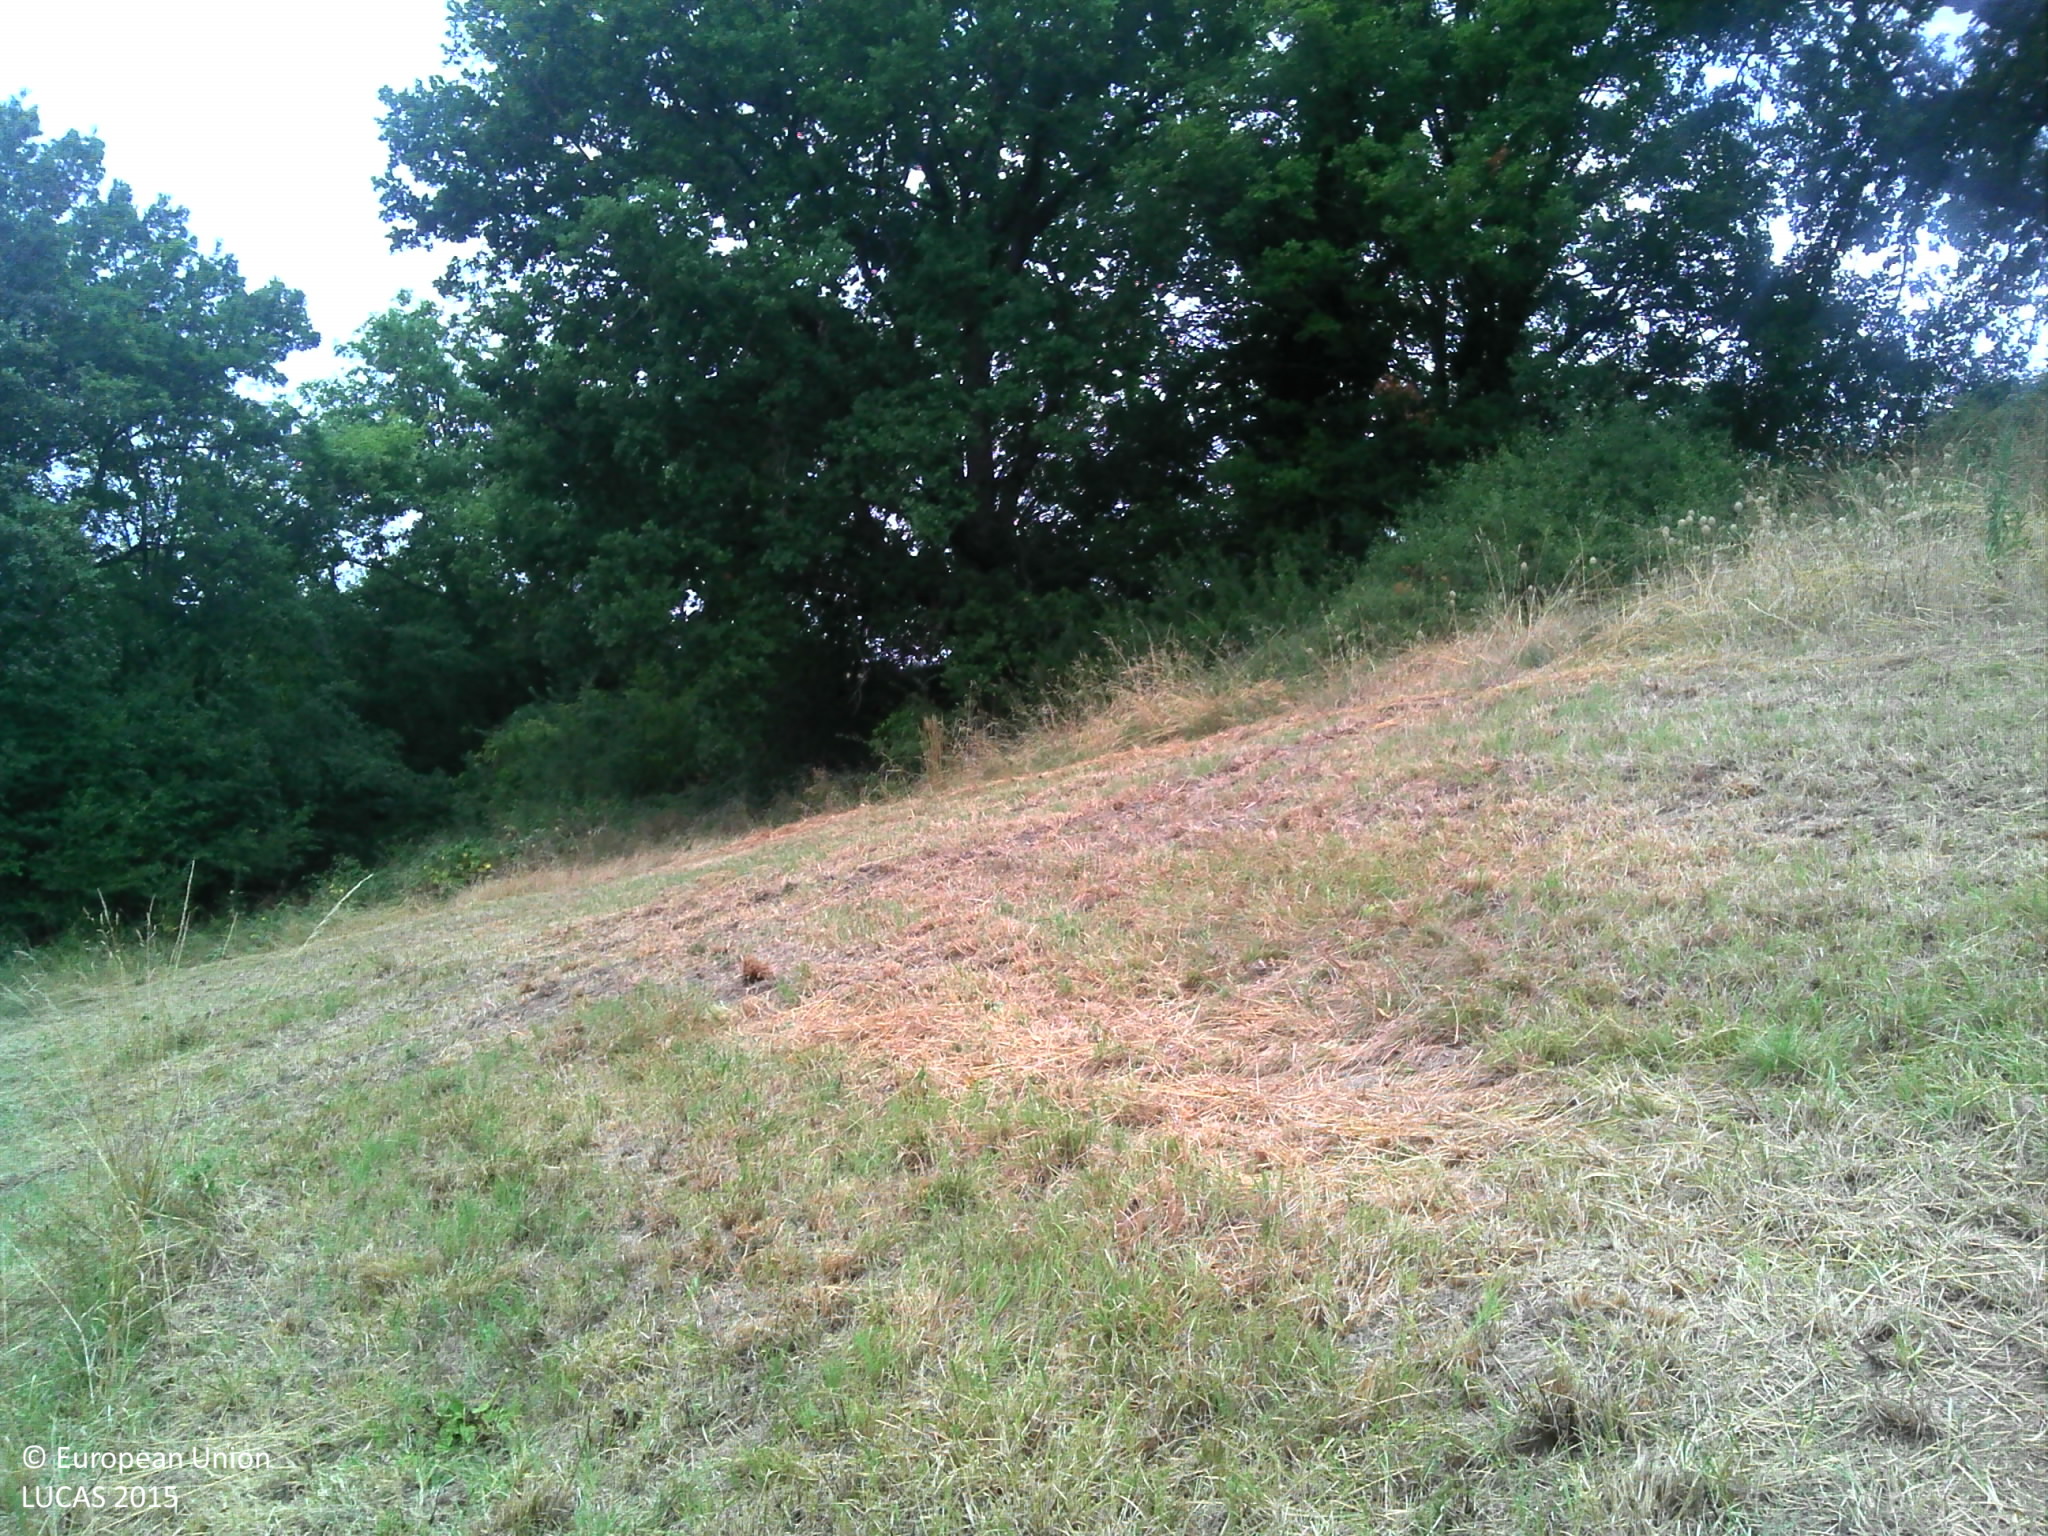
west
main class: Grassland
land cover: Grassland without tree/shrub cover
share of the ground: > 75 %
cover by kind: herbaceous plants 100 %
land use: Agriculture (excluding fallow land and kitchen gardens)
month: July
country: FR
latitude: 44.2082
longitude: 0.9485
